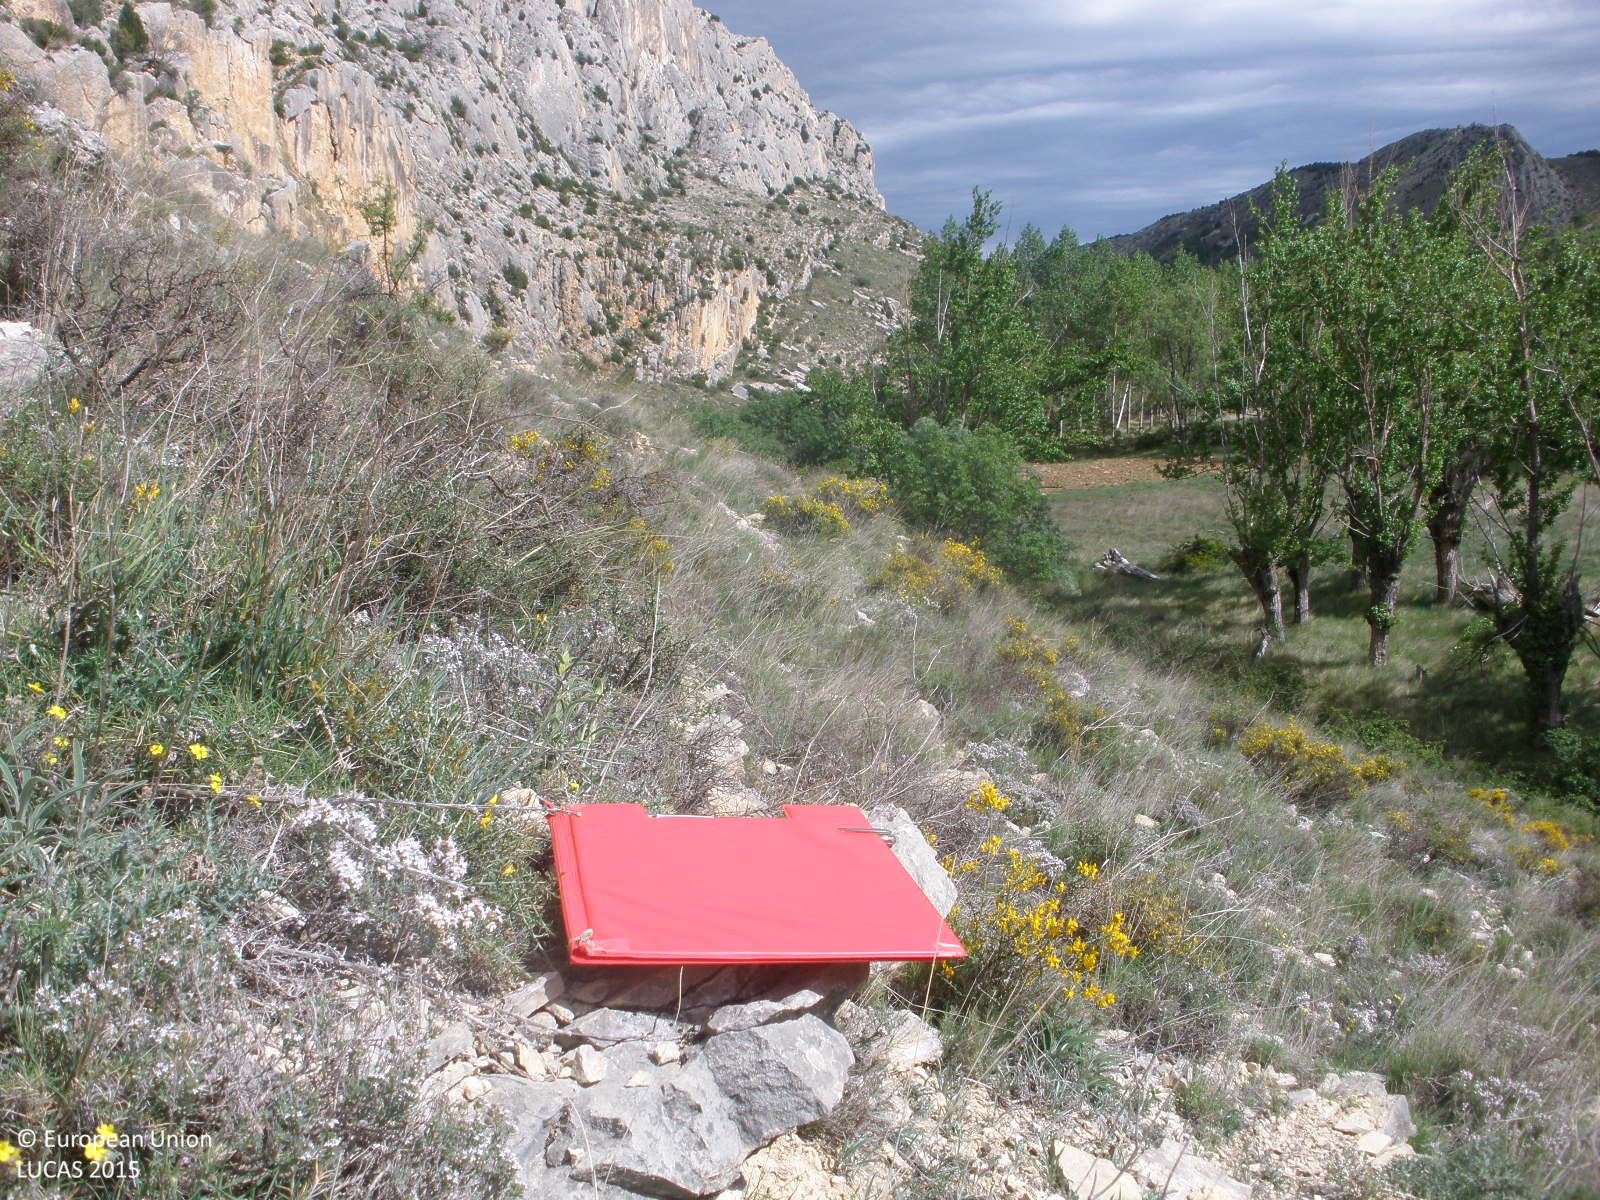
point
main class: Shrubland
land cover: Shrubland without tree cover
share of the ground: > 75 %
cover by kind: shrubs 70 %, herbaceous plants 15 %, consolidated bare surface 15 %
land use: Semi-natural and natural areas not in use
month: May
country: ES
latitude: 41.0054
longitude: -0.9186
